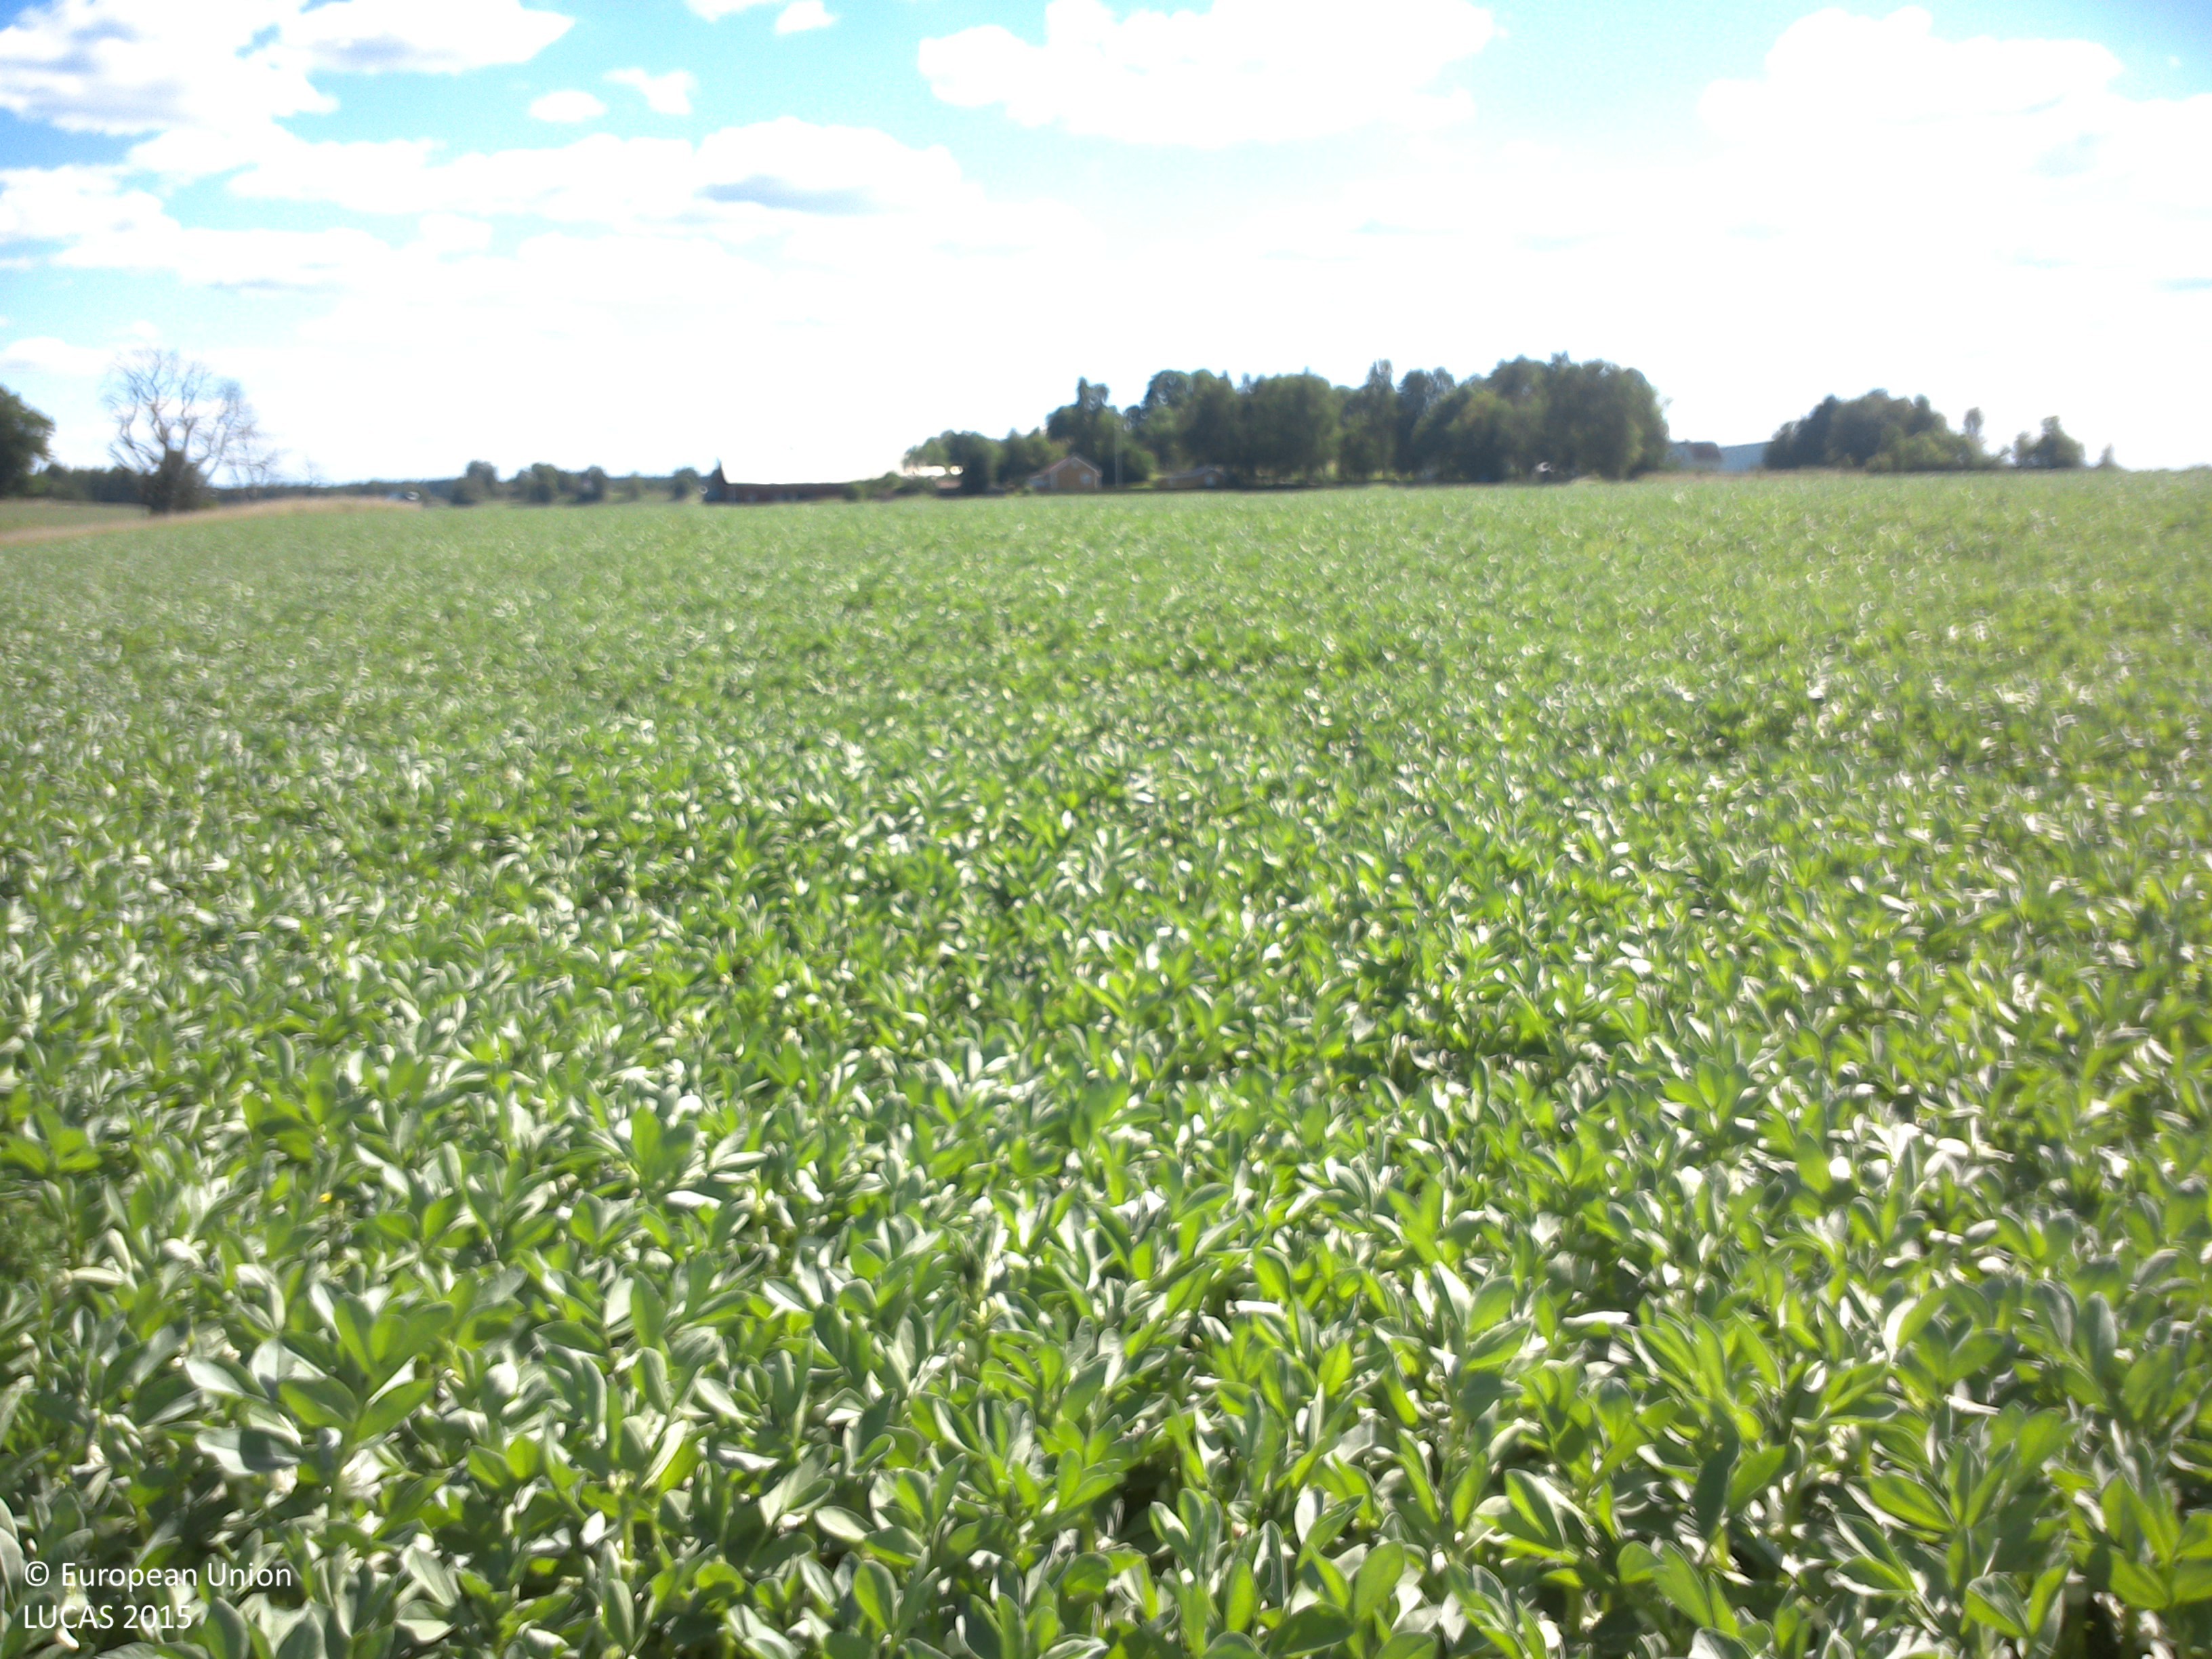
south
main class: Cropland
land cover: Dry pulses
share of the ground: > 75 %
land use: Agriculture (excluding fallow land and kitchen gardens)
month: July
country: SE
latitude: 58.3092
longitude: 15.4047
